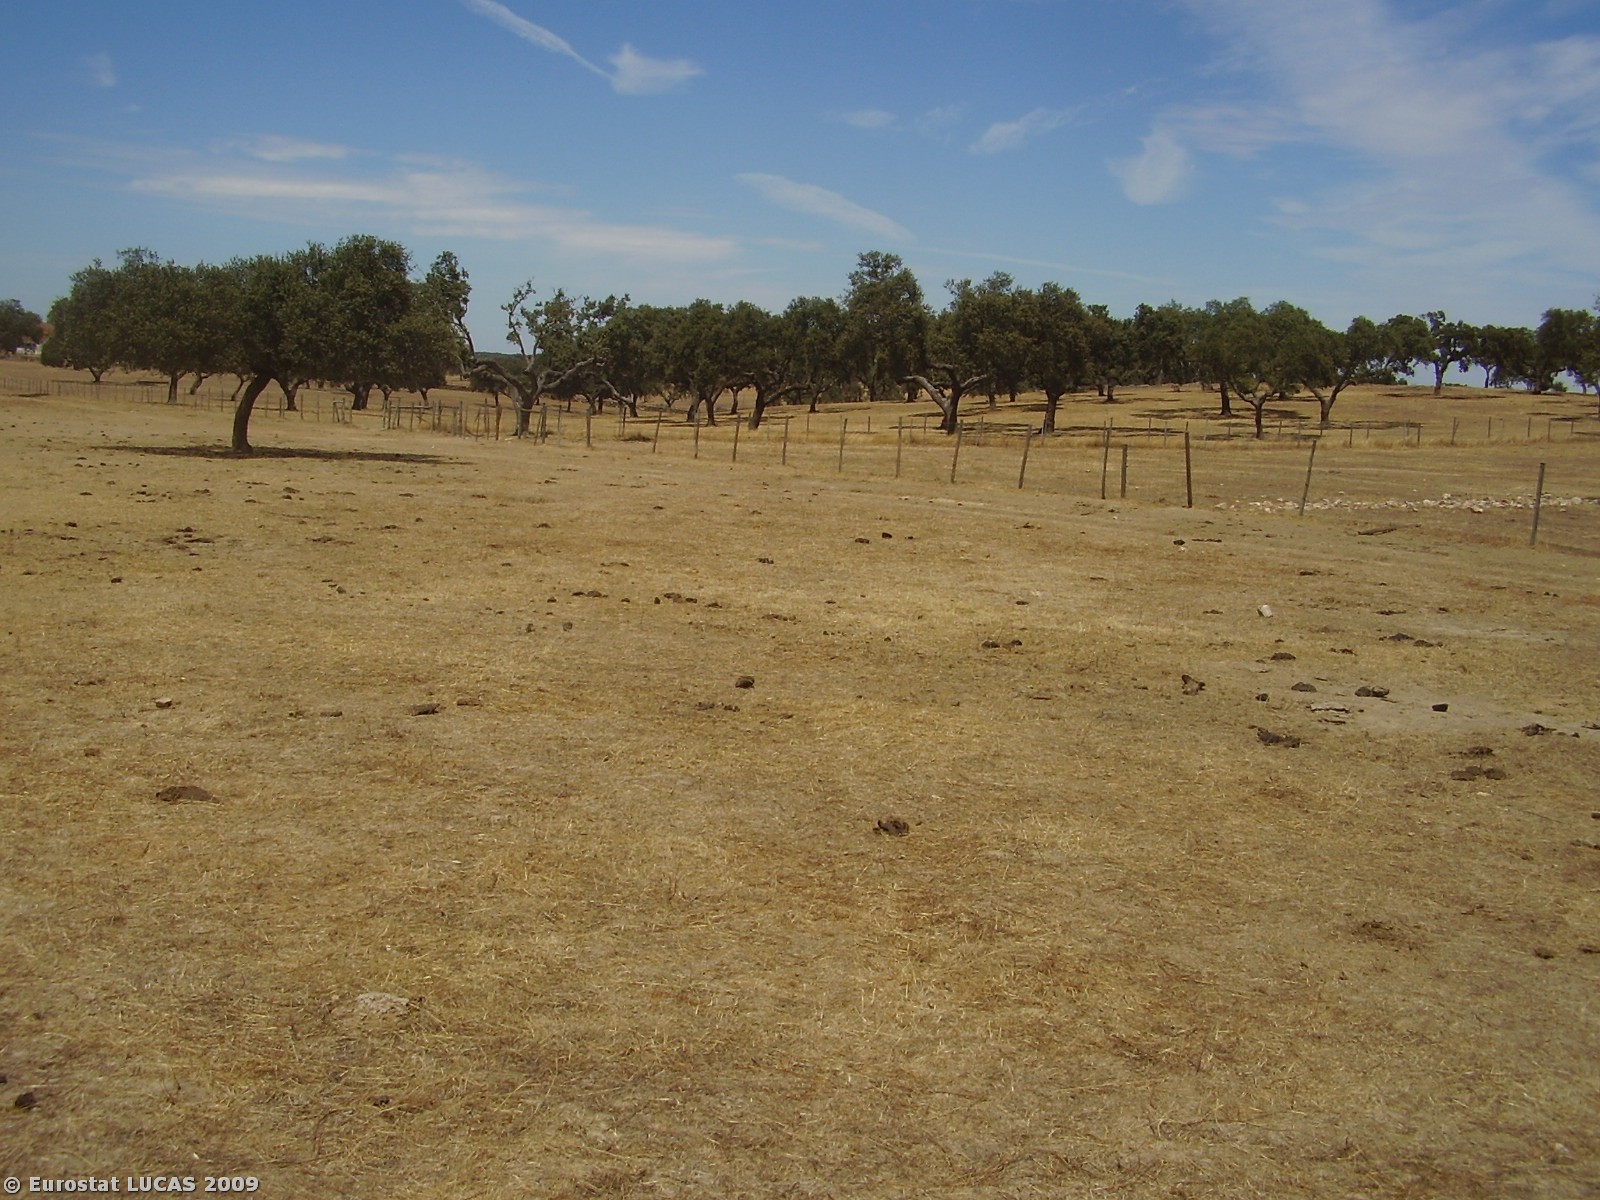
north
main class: Woodland
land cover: Broadleaved woodland
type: broadleaved evergreen forest
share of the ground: 10 - 25 %
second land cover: Grassland with sparse tree/shrub cover
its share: > 75 %
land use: Forestry
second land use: Fallow land
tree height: > 5 m
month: August
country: PT
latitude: 38.2607
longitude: -7.1712
